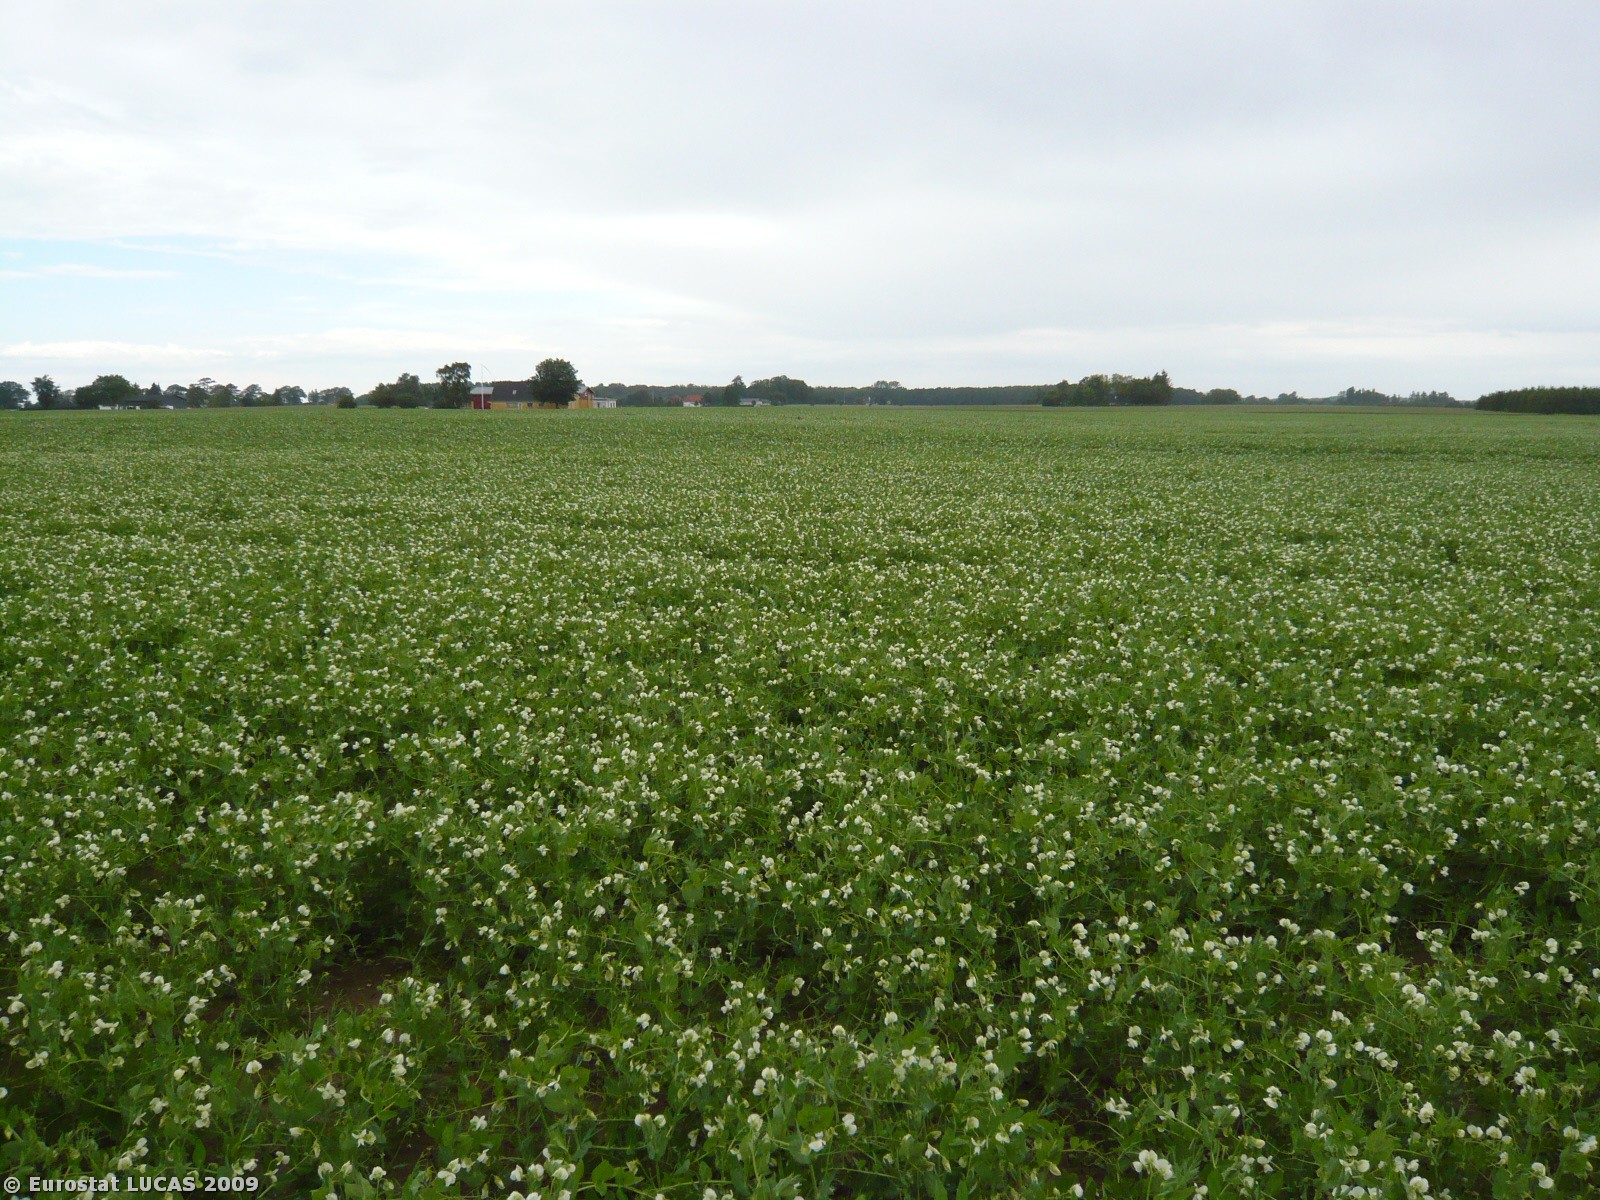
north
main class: Cropland
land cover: Dry pulses
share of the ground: > 75 %
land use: Agriculture (excluding fallow land and kitchen gardens)
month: June
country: DK
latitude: 54.8122
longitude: 11.5394
